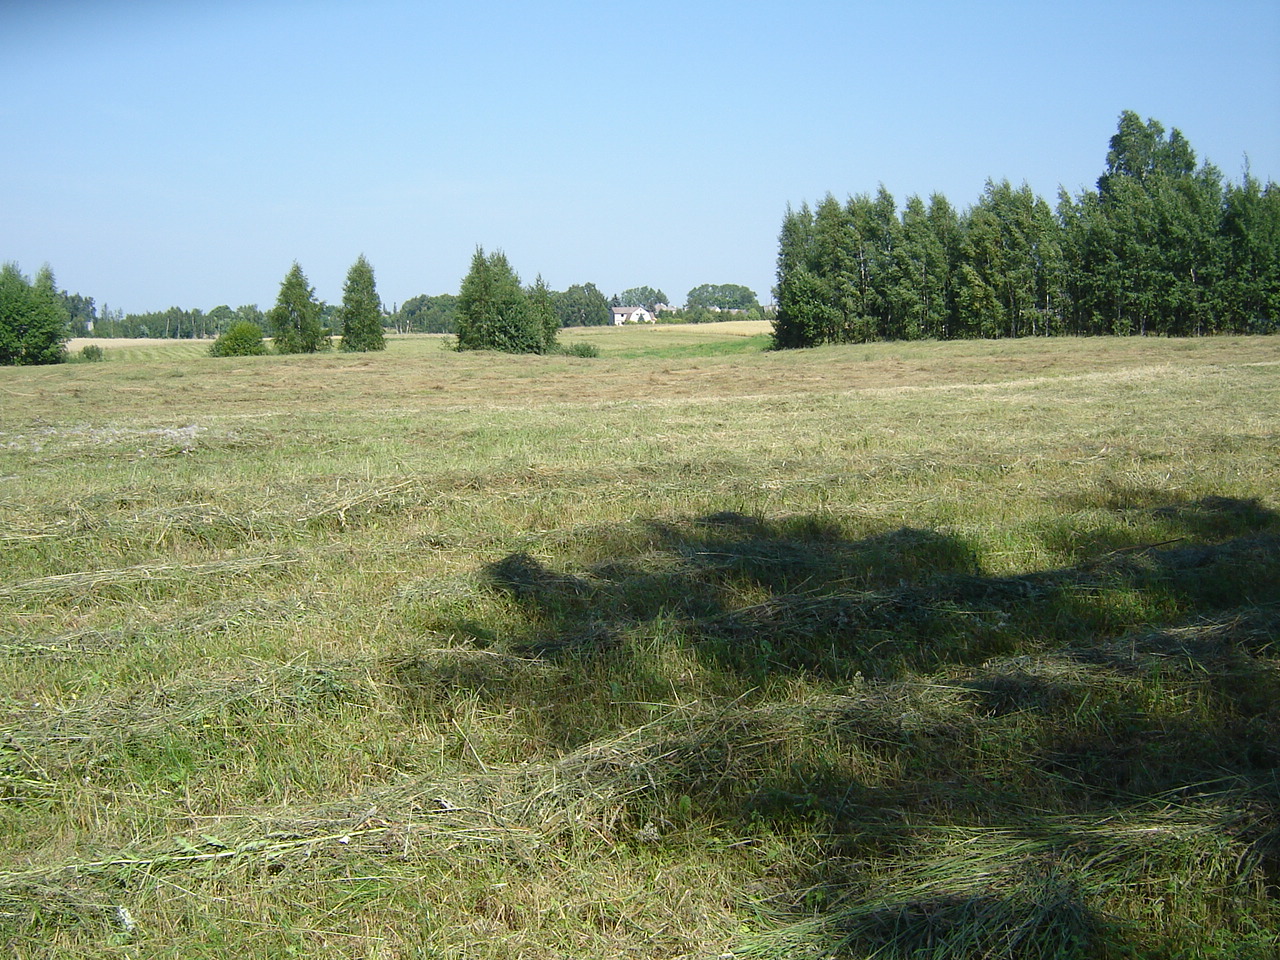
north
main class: Grassland
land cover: Grassland without tree/shrub cover
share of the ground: > 75 %
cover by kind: herbaceous plants 100 %
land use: Agriculture (excluding fallow land and kitchen gardens)
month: August
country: LT
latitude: 55.2078
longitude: 24.9942
